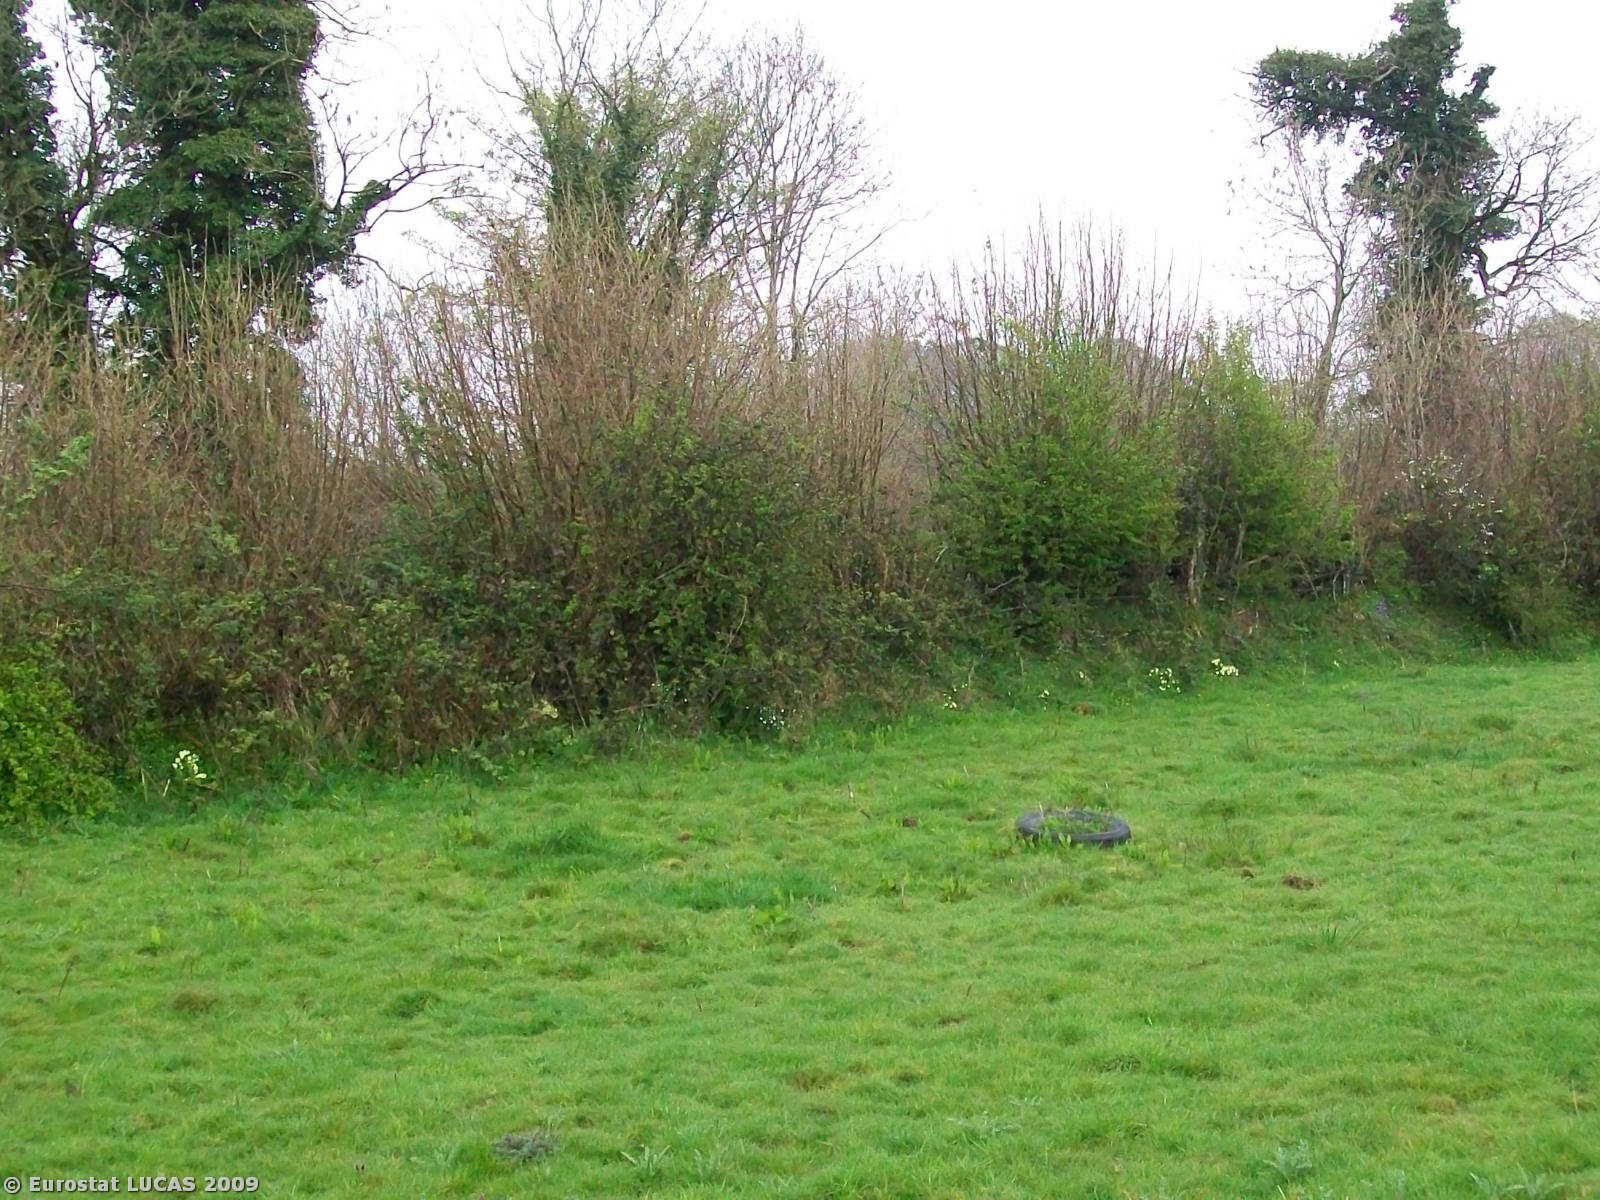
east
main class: Grassland
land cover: Grassland without tree/shrub cover
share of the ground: > 75 %
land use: Agriculture (excluding fallow land and kitchen gardens)
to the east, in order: Grassland without tree/shrub cover; Managed hedges; Grass margins; Paved roads, cycling and walking lanes; Grass margins; Abandoned hedges; Grassland without tree/shrub cover; Abandoned hedges; Grassland without tree/shrub cover; Dry stone walls; Grassland without tree/shrub cover
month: April
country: IE
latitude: 53.5839
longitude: -8.1402
